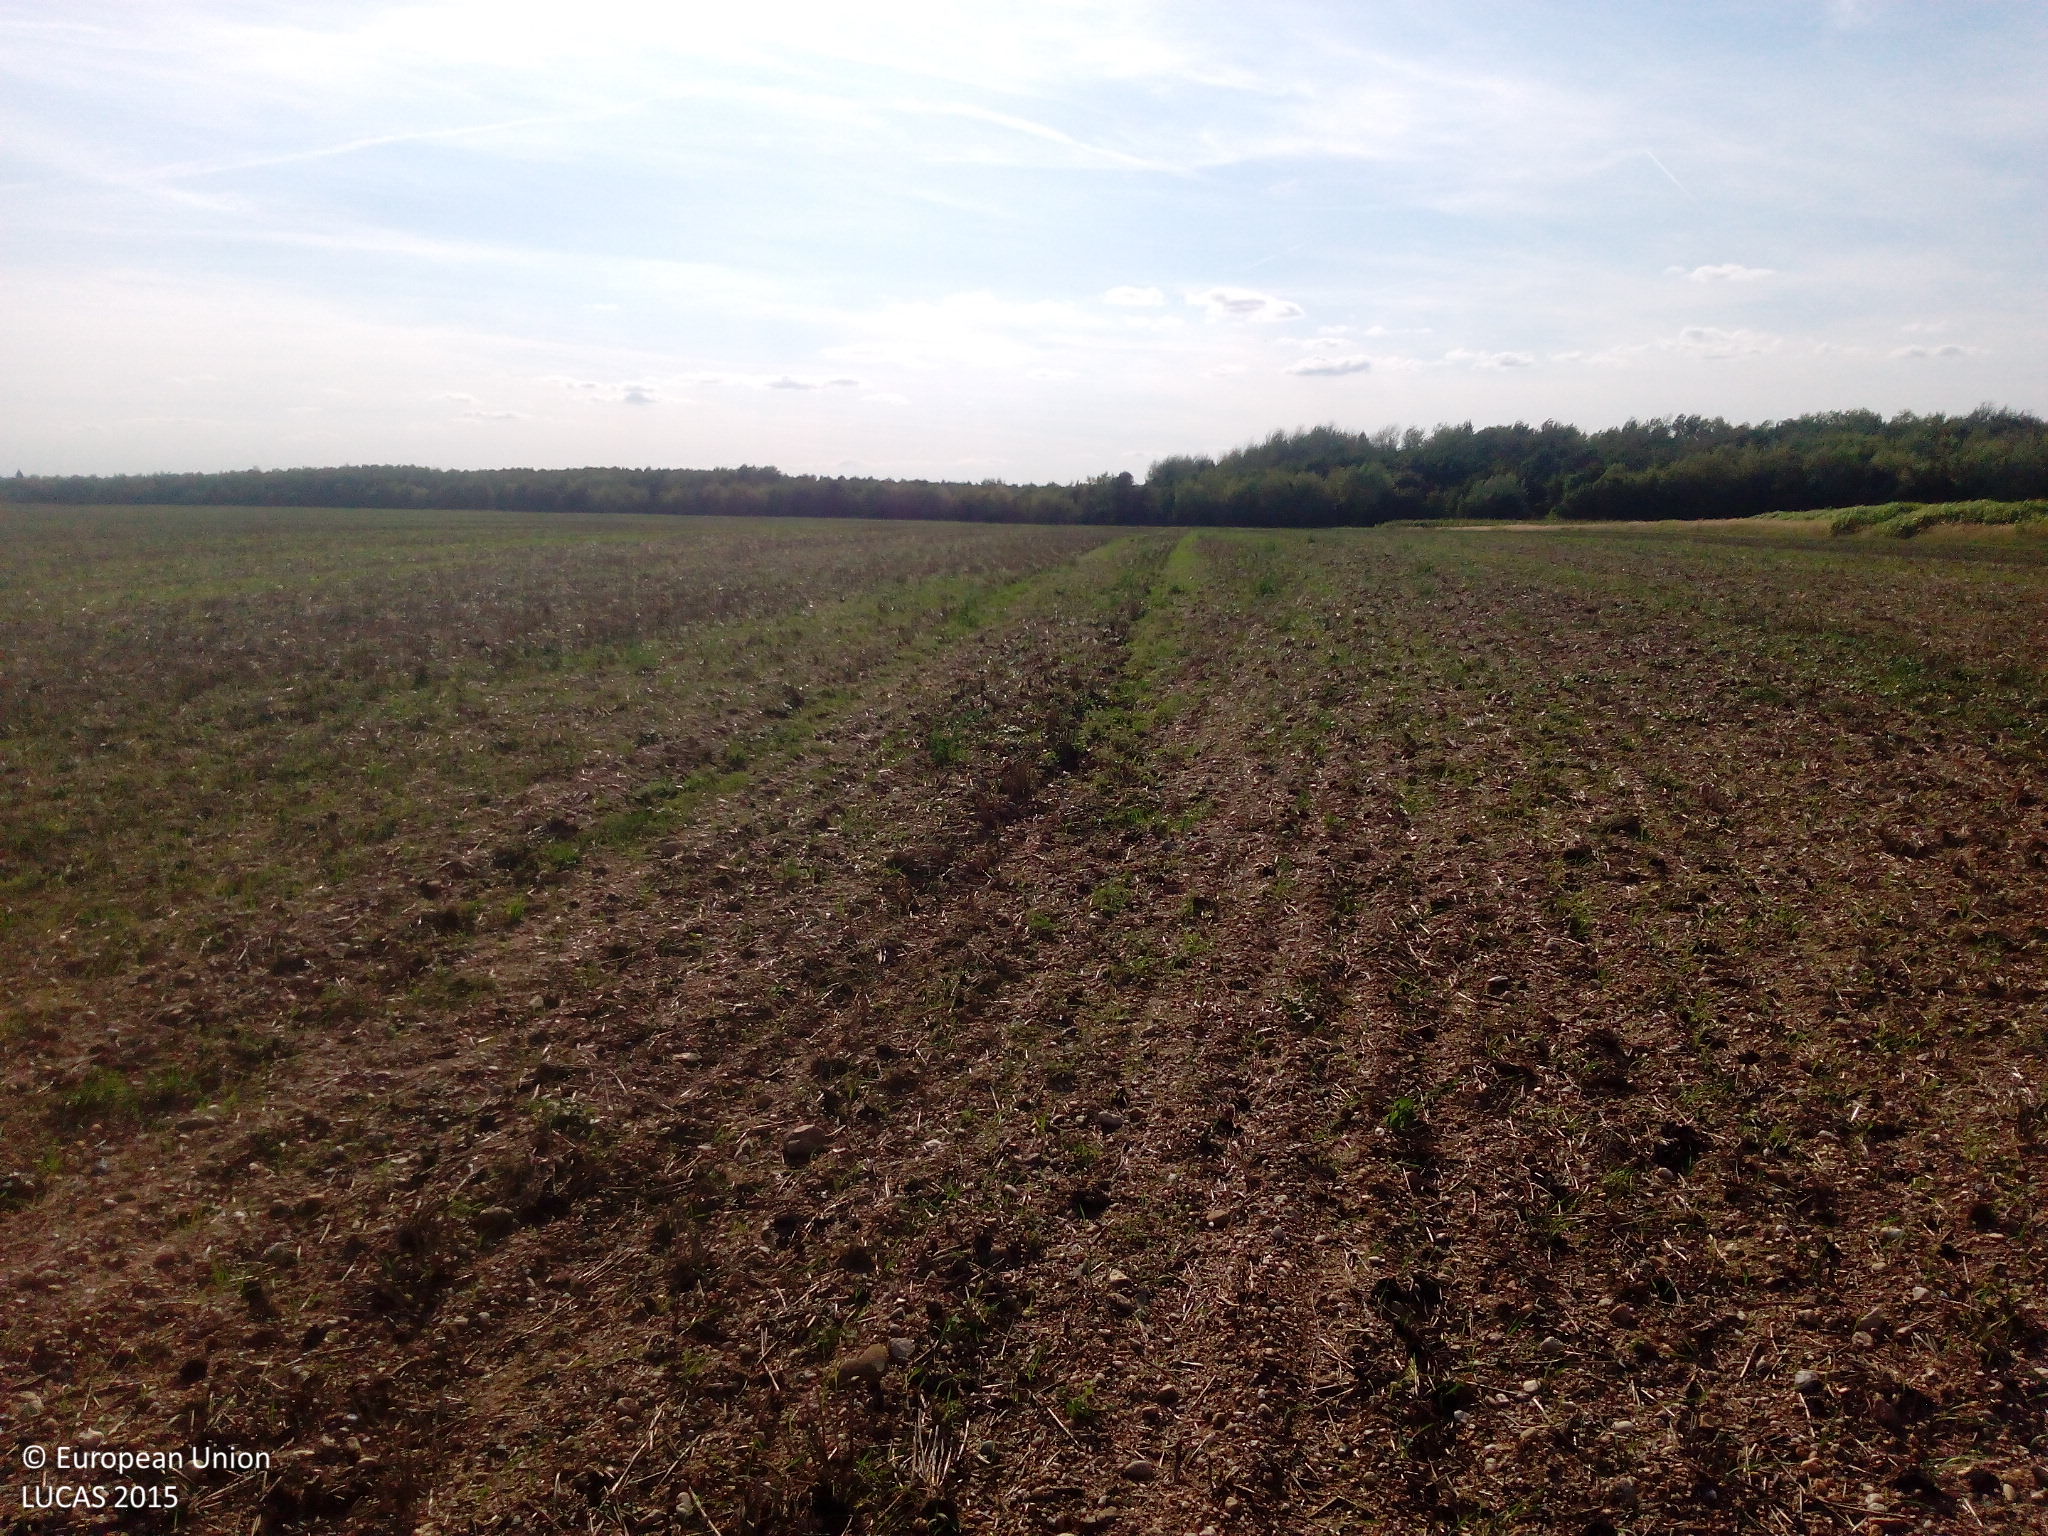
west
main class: Cropland
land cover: Common wheat
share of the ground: < 10 %
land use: Agriculture (excluding fallow land and kitchen gardens)
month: August
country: DE
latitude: 51.2390
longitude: 12.3631
